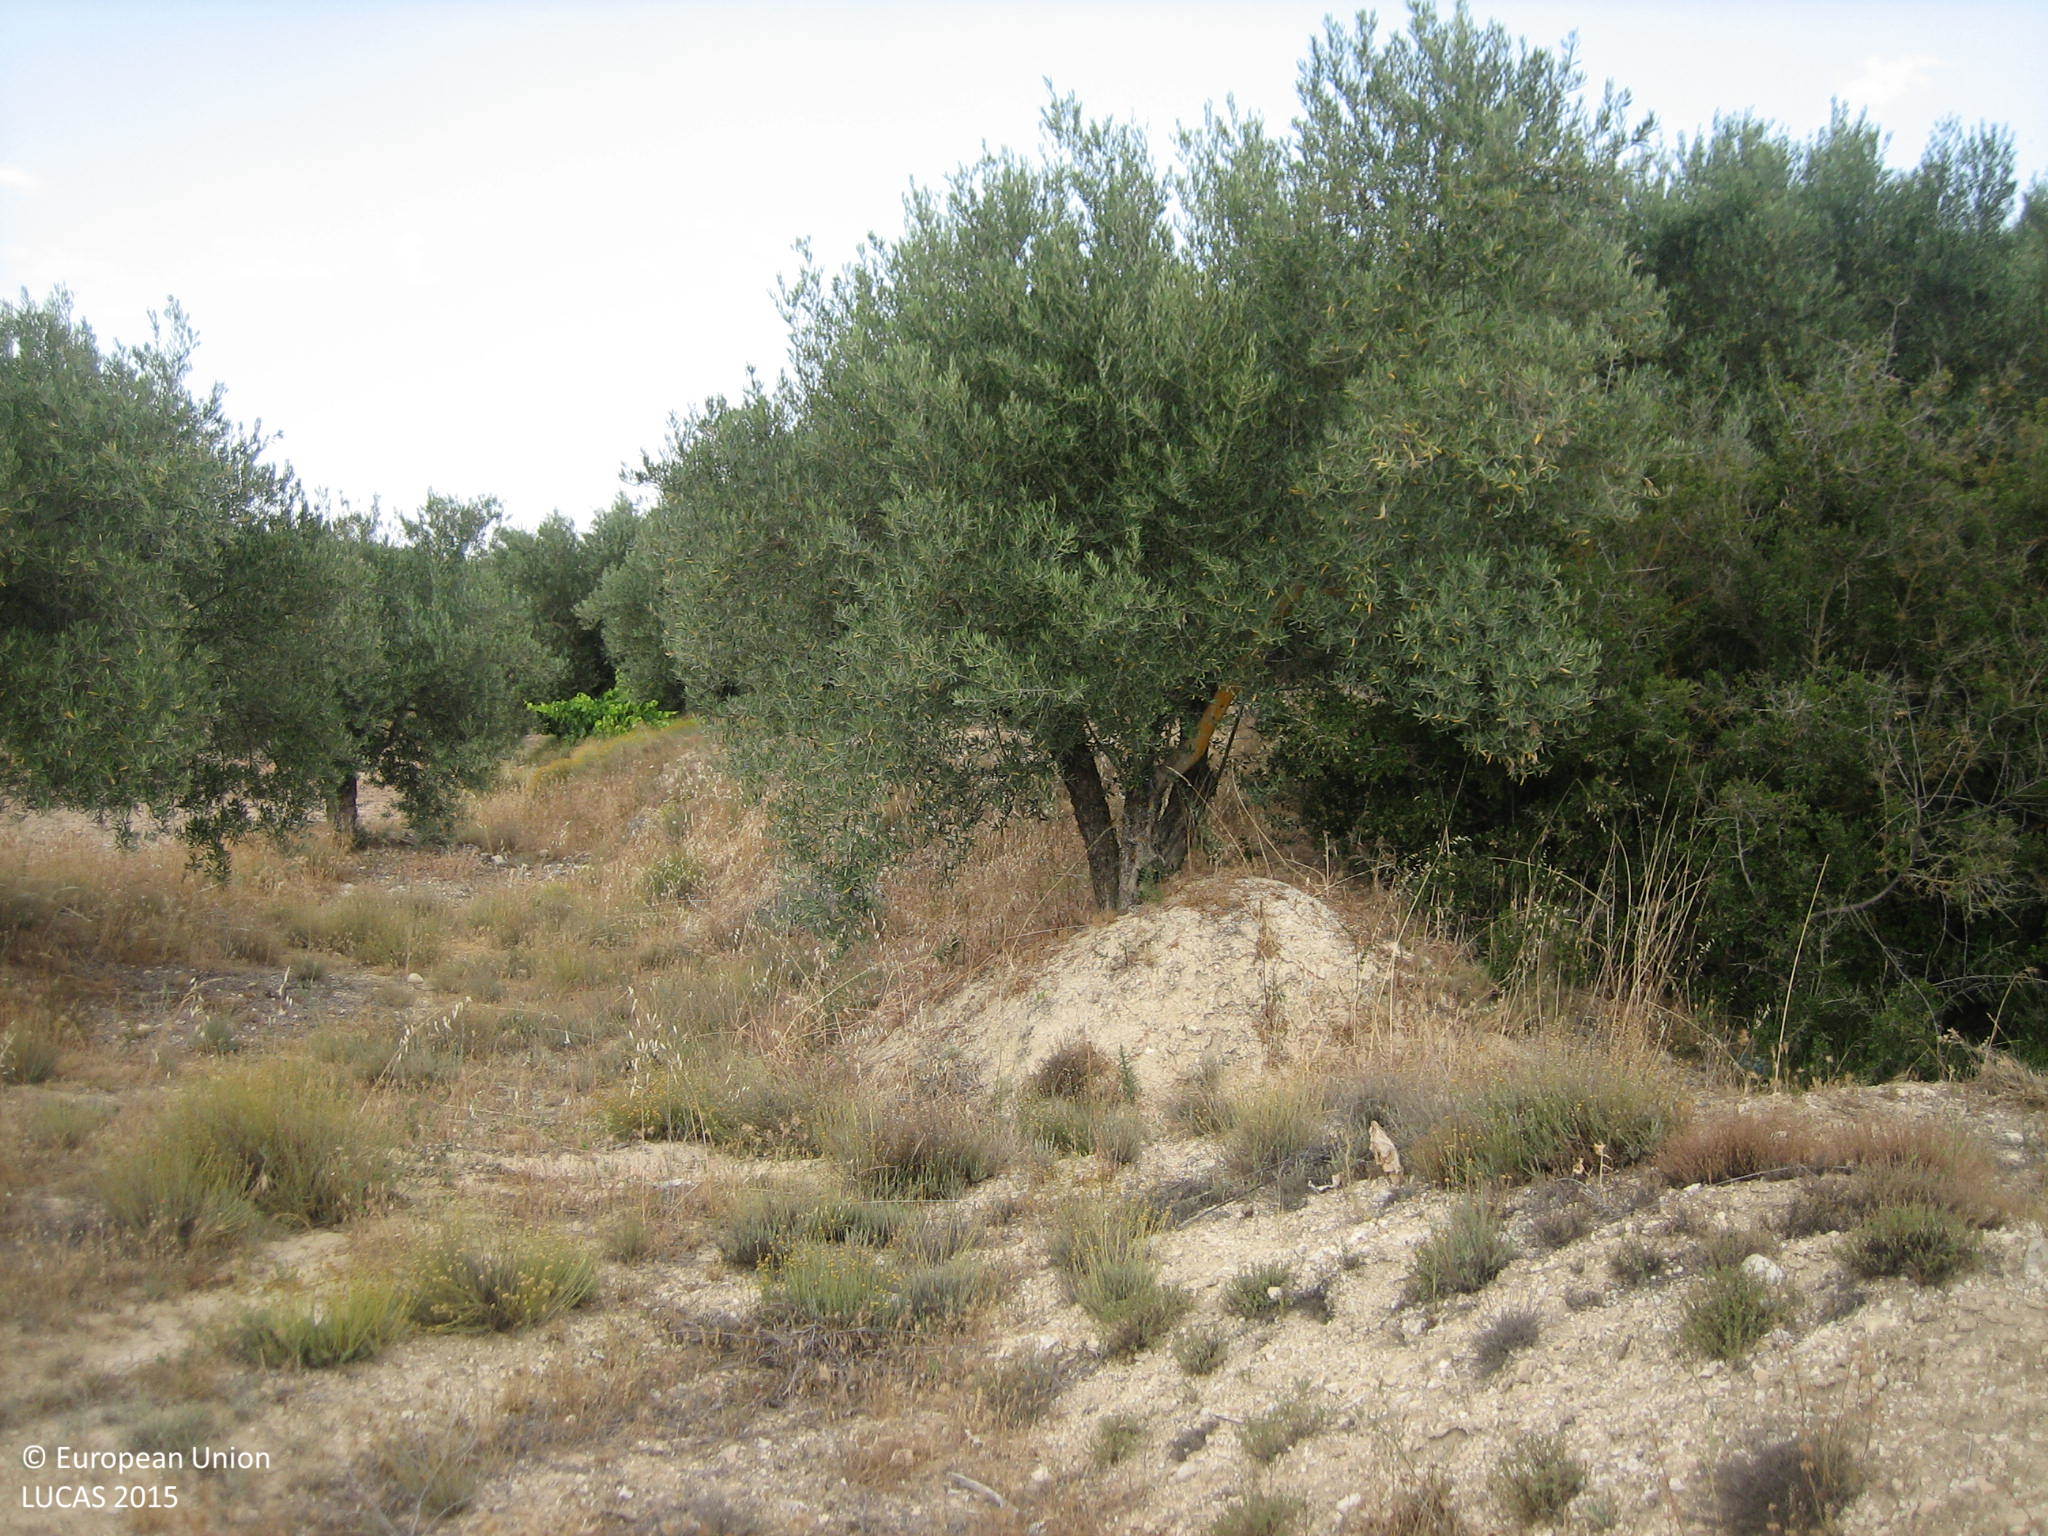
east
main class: Cropland
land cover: Olive groves
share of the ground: 10 - 25 %
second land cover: Spontaneously vegetated surfaces
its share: 50 - 75 %
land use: Agriculture (excluding fallow land and kitchen gardens)
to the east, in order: Olive groves; Spontaneously vegetated surfaces; Electric lines; Olive groves
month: July
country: ES
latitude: 37.6503
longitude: -2.9230
